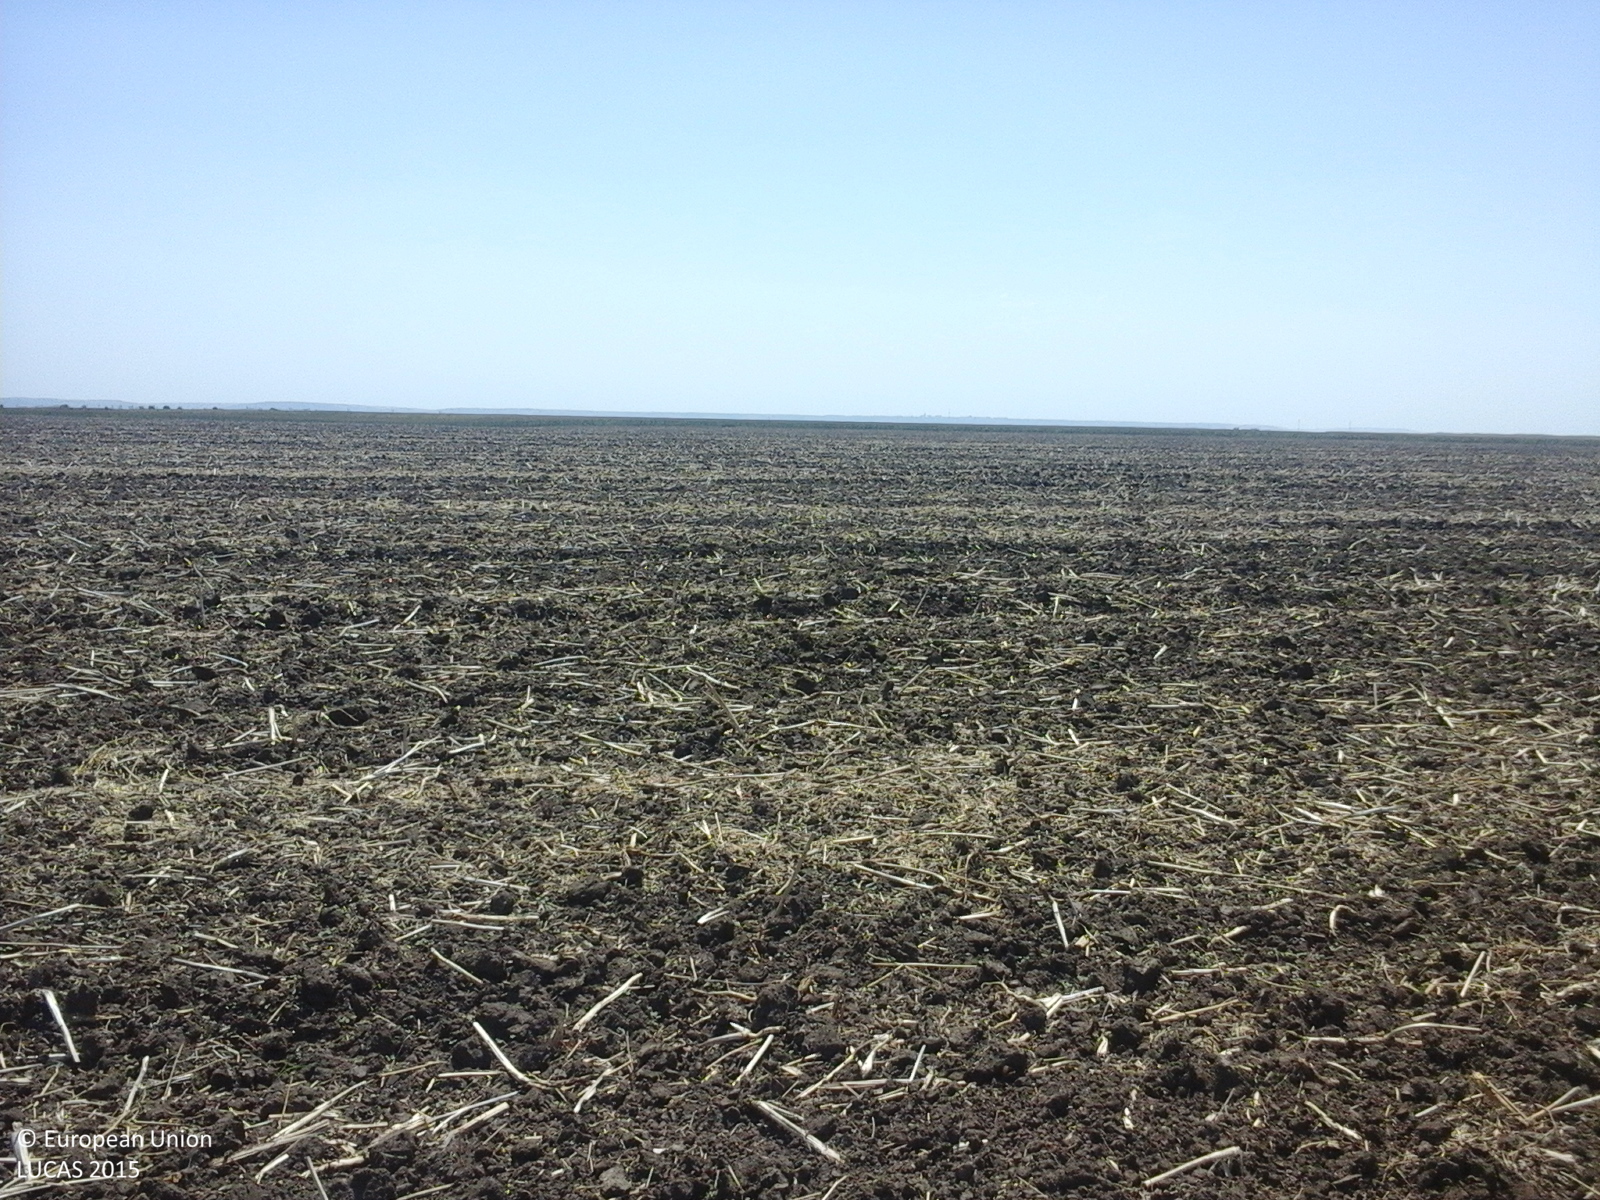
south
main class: Cropland
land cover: Rape and turnip rape
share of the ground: < 10 %
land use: Agriculture (excluding fallow land and kitchen gardens)
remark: Harvested field
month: July
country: RO
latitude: 44.1861
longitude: 26.6674
